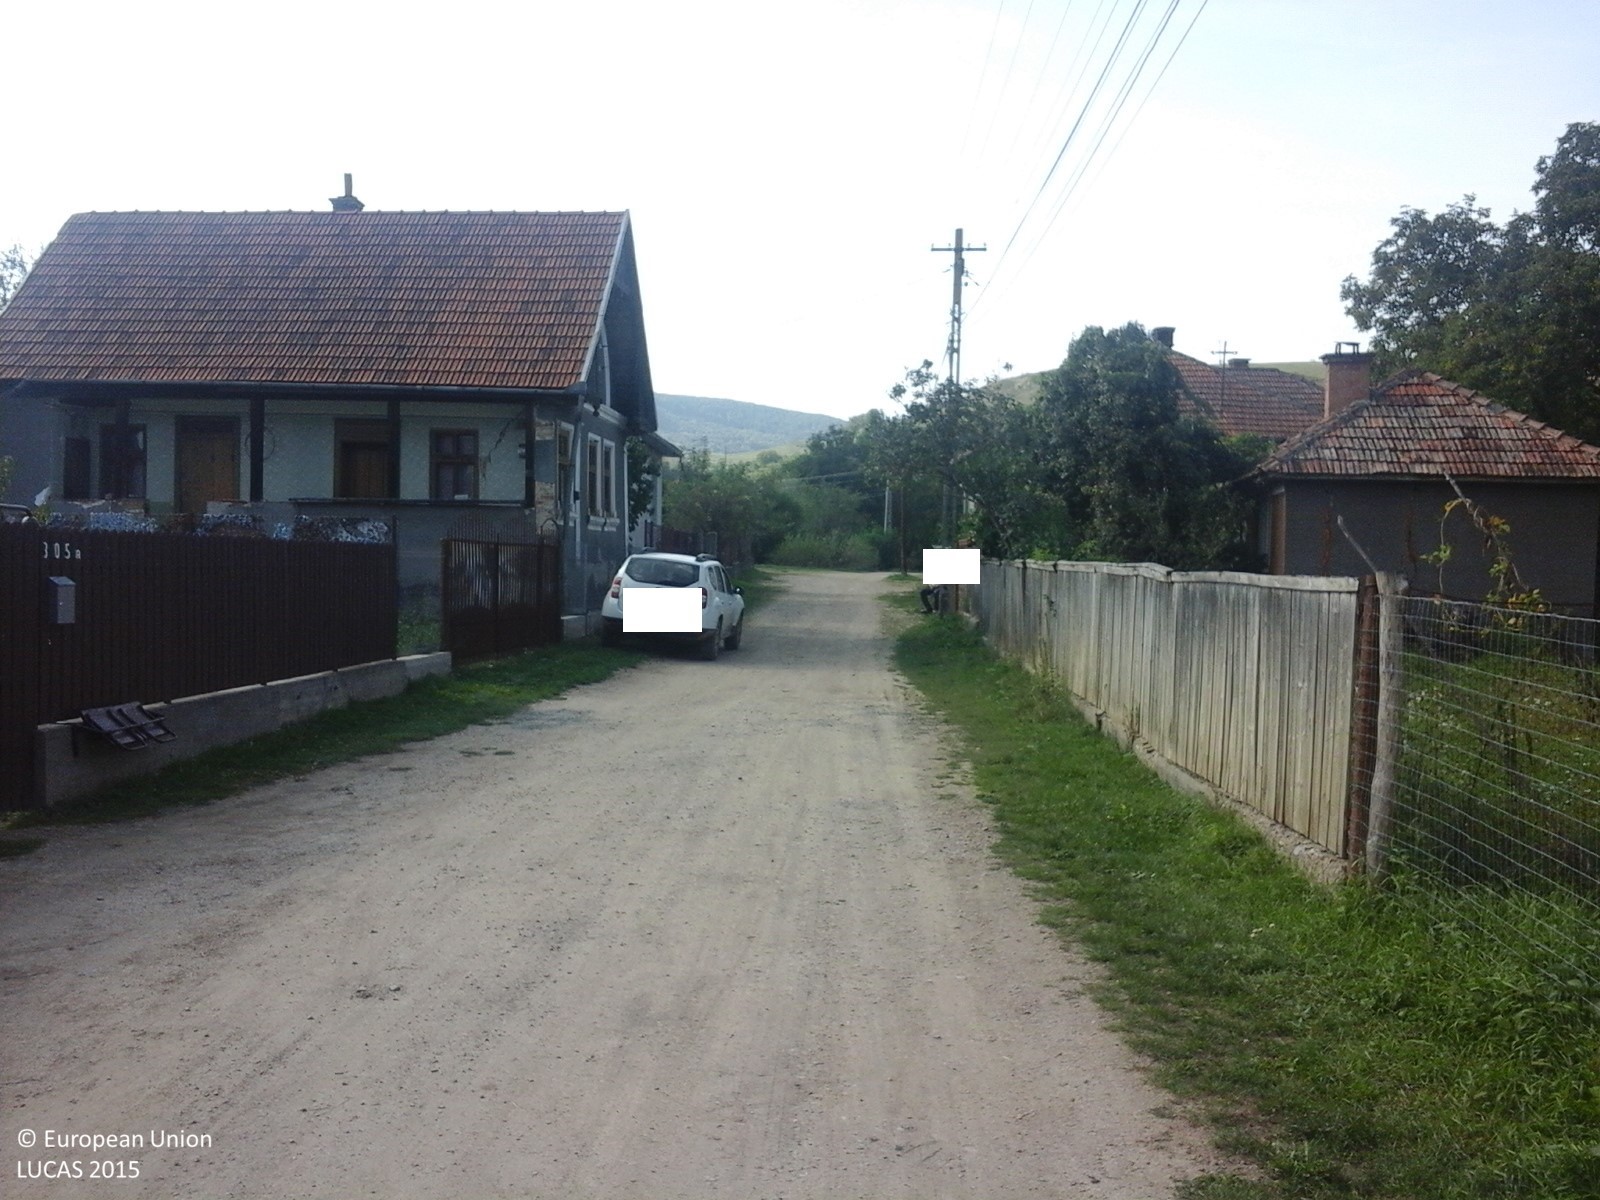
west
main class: Cropland
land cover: Apple fruit
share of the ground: > 75 %
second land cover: Grassland without tree/shrub cover
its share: > 75 %
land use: Agriculture (excluding fallow land and kitchen gardens)
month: September
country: RO
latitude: 46.7983
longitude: 23.2591
